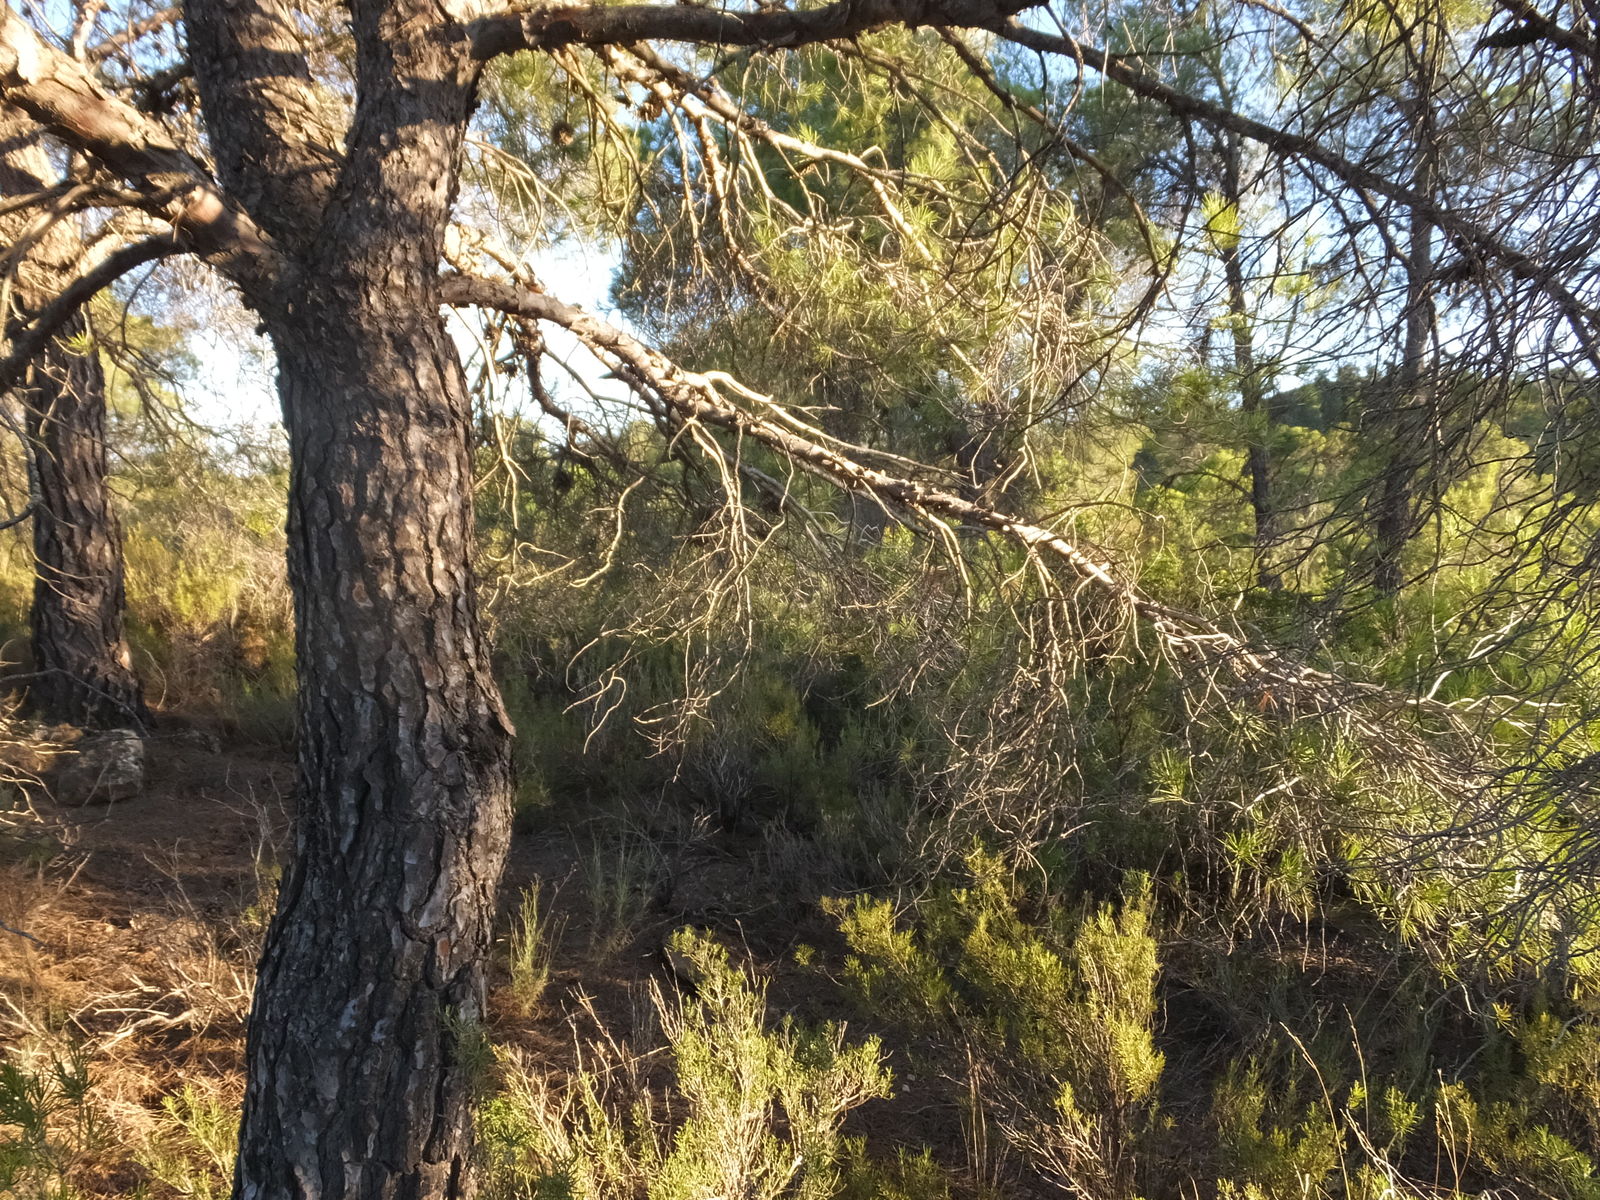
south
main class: Woodland
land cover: Pine dominated mixed woodland
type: coniferous forest of the mediterranean region
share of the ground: 50 - 75 %
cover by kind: coniferous forest trees 60 %, broadleaved forest trees 20 %, shrubs 20 %
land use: Forestry
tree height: > 5 m
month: August
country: ES
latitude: 41.2064
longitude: 0.1260
